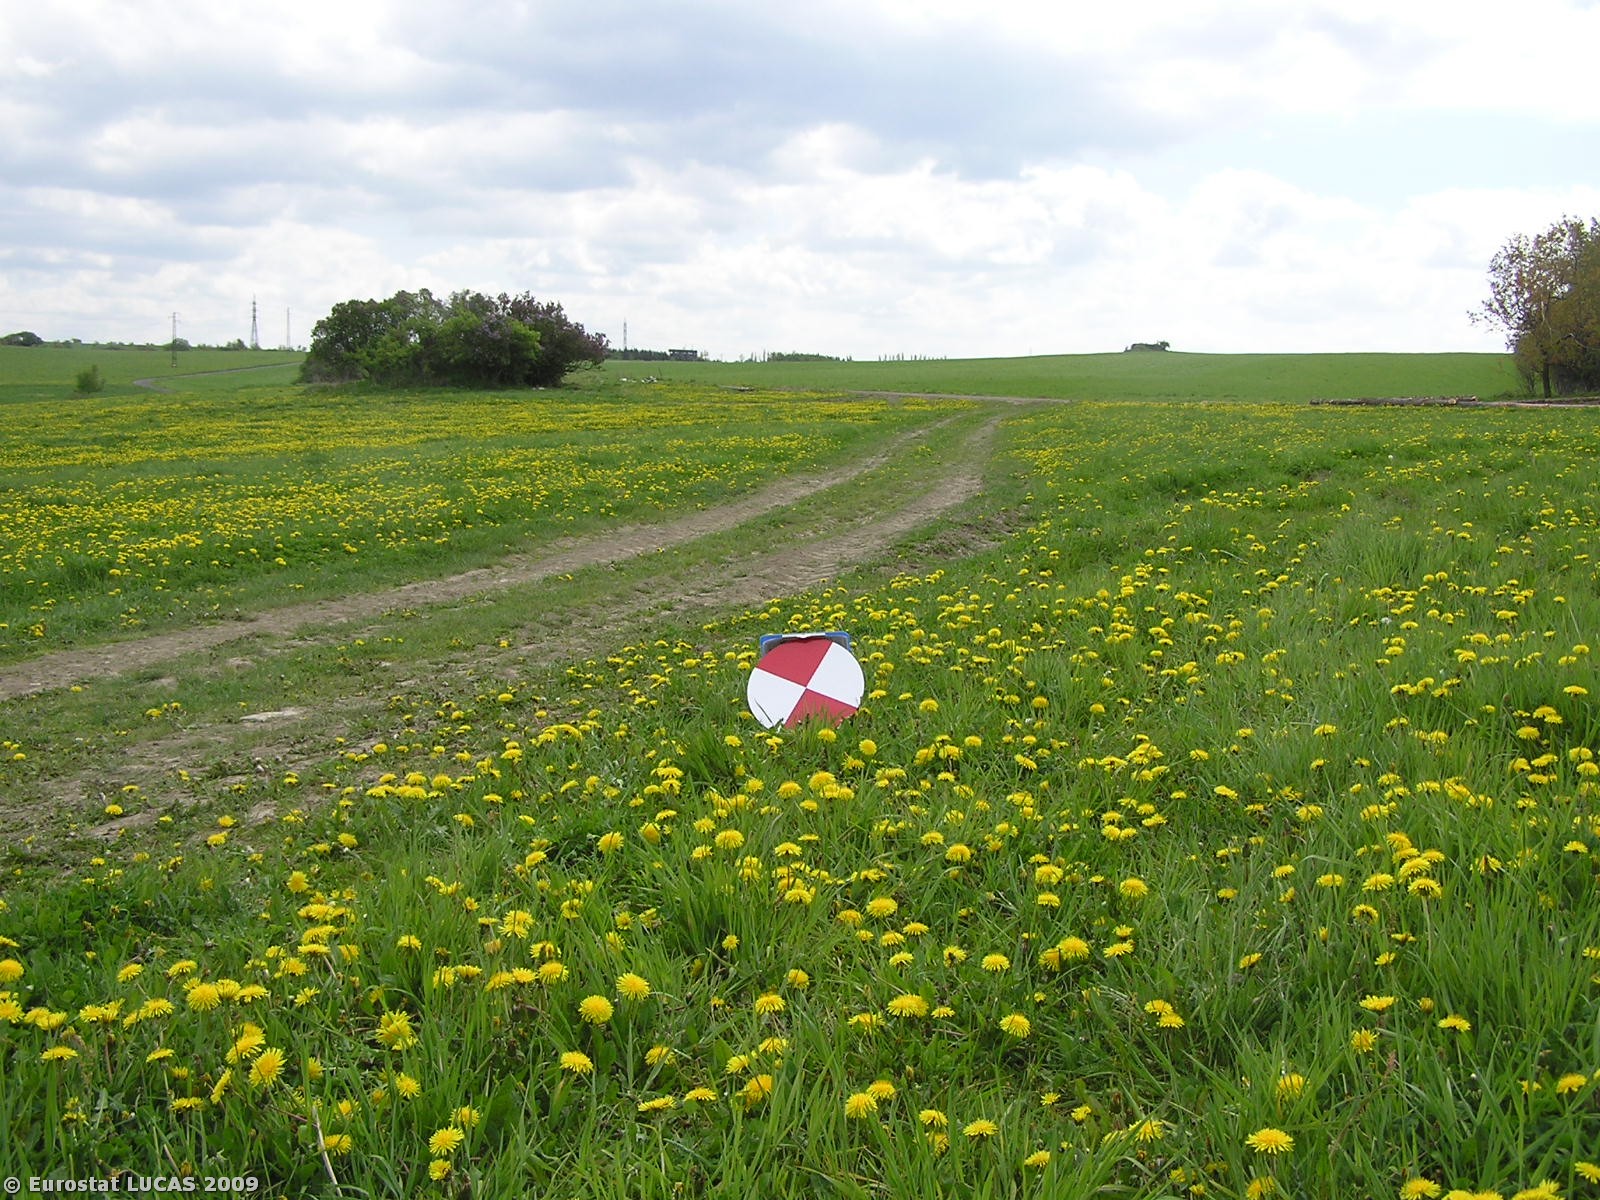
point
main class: Grassland
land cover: Grassland without tree/shrub cover
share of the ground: > 75 %
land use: Agriculture (excluding fallow land and kitchen gardens)
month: May
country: CZ
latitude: 49.9837
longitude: 17.6138
